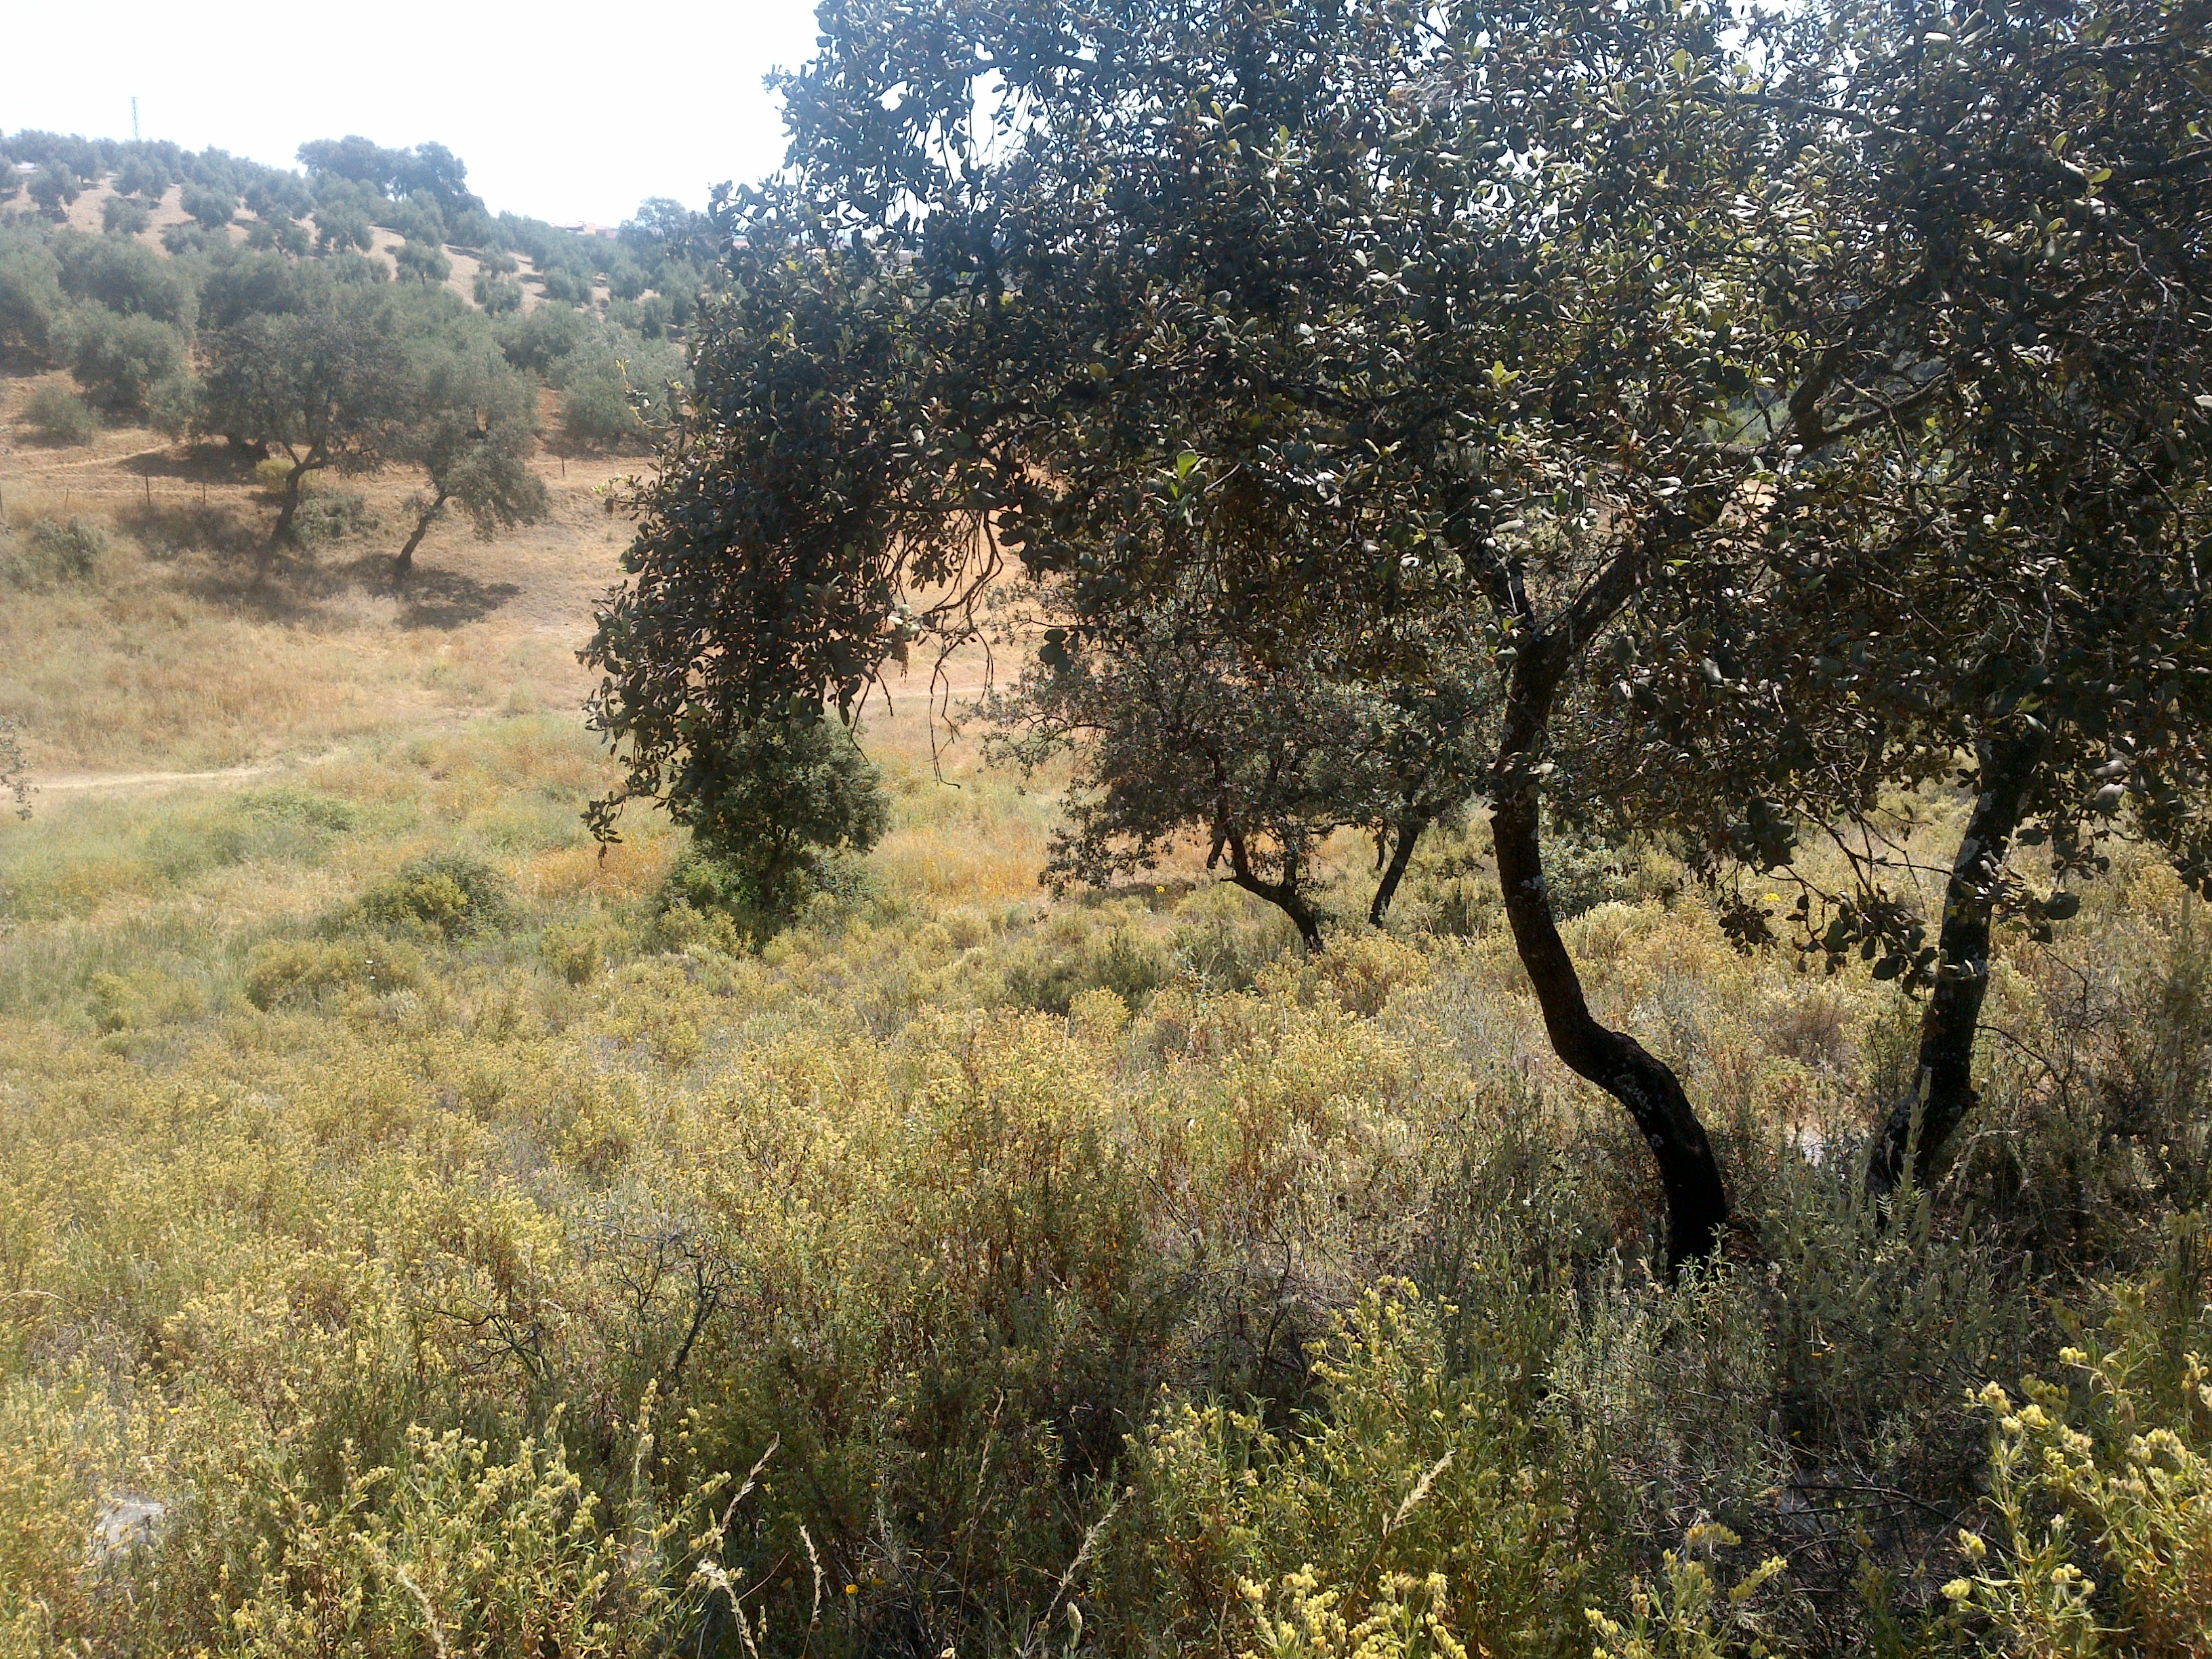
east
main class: Woodland
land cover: Broadleaved woodland
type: broadleaved evergreen forest
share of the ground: 10 - 25 %
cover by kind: shrubs 60 %, broadleaved forest trees 20 %, herbaceous plants 20 %
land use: Semi-natural and natural areas not in use
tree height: < 5 m
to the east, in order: Broadleaved woodland; Shrubland without tree cover; Grassland with sparse tree/shrub cover; Rivers and streams; Grassland with sparse tree/shrub cover; Tracks; Groves; Fences; Olive groves; Grass margins; Rivers and streams; Grass margins; Fences; Olive groves; Electric lines; Olive groves; Single bushes/trees; Olive groves
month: May
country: ES
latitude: 38.0212
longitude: -4.5373
